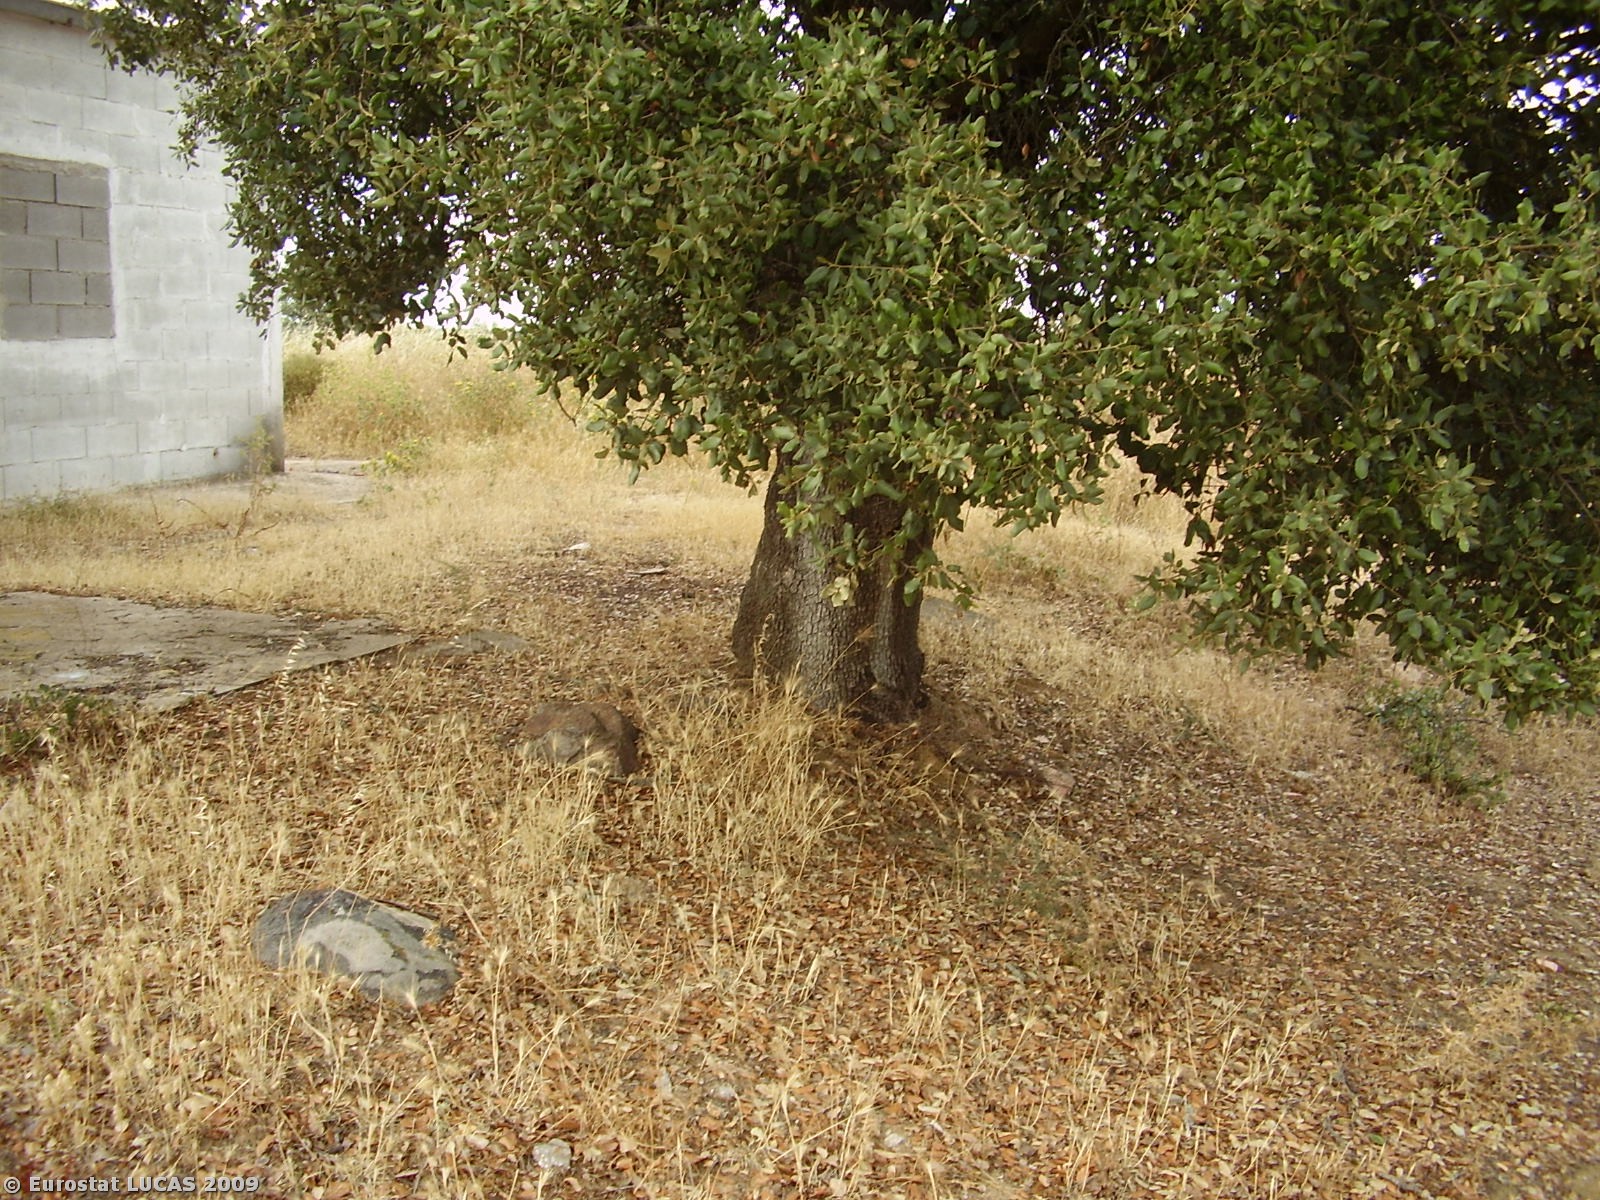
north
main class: Woodland
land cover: Broadleaved woodland
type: broadleaved evergreen forest
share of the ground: 10 - 25 %
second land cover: Bare land
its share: 50 - 75 %
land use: Forestry
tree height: > 5 m
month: July
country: PT
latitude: 38.7197
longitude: -7.7861
